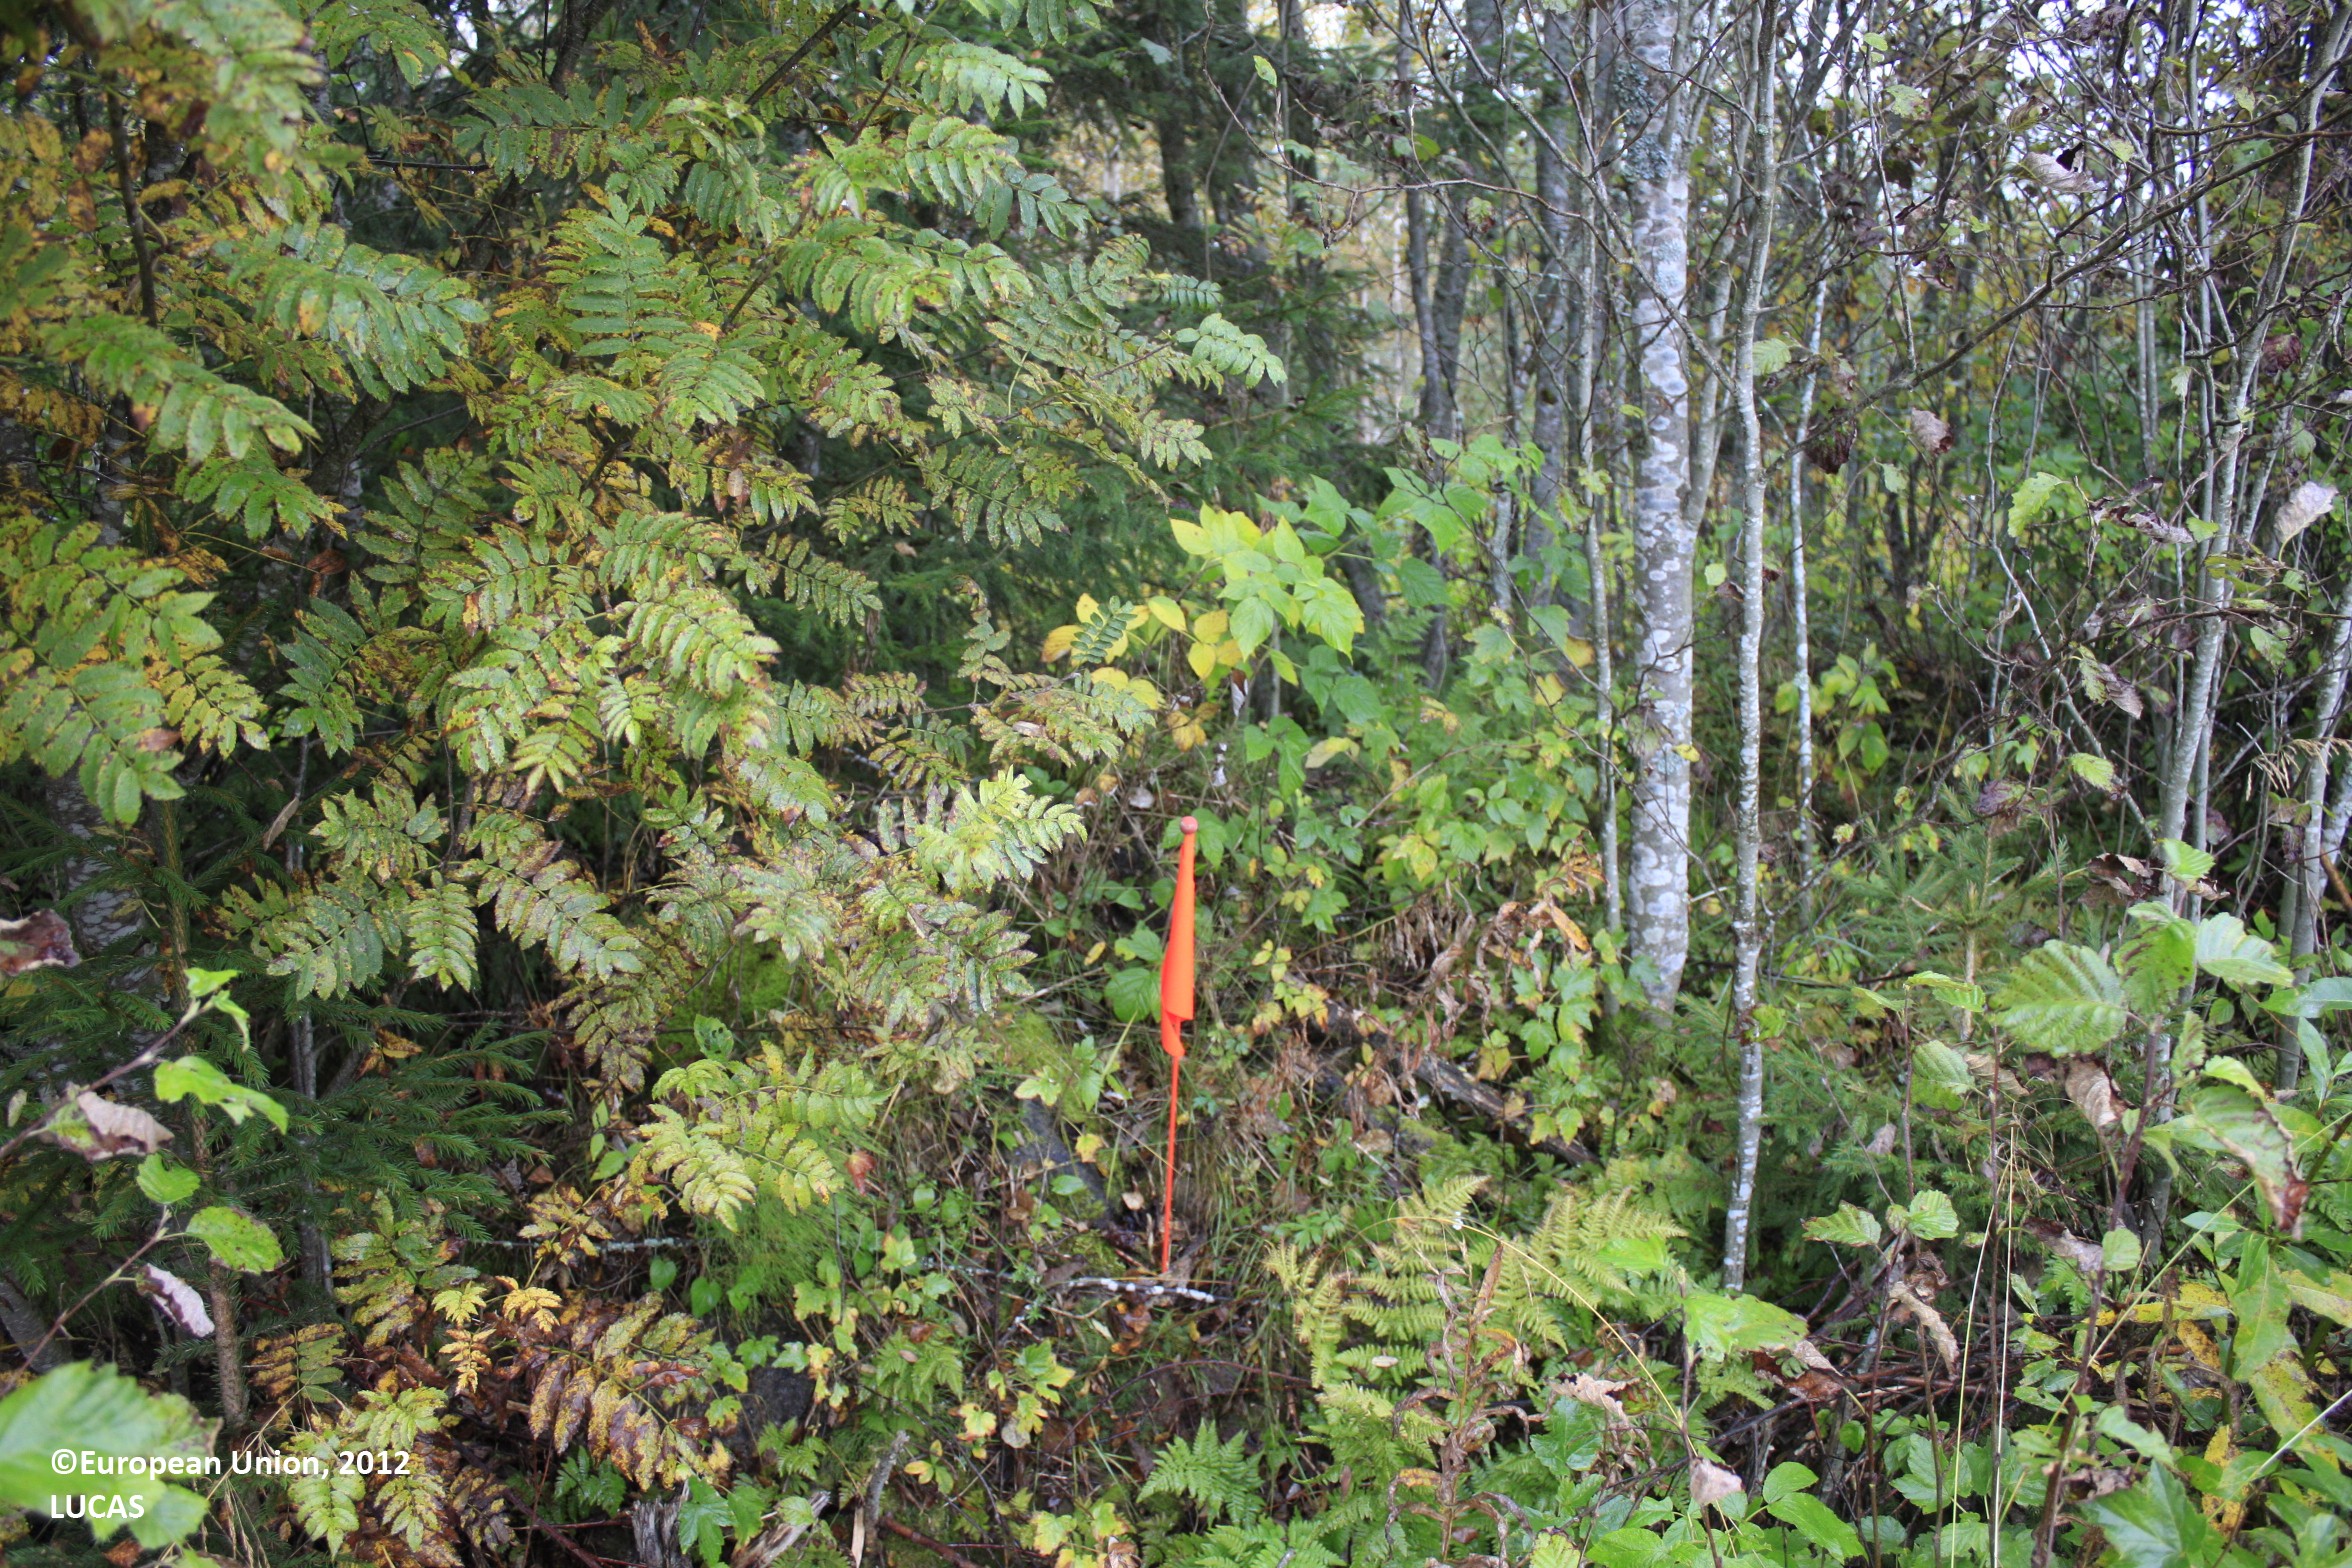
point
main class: Woodland
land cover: Spruce dominated mixed woodland
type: boreal forest
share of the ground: 50 - 75 %
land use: Forestry
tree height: > 5 m
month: September
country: FI
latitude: 63.6559
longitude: 25.9663
